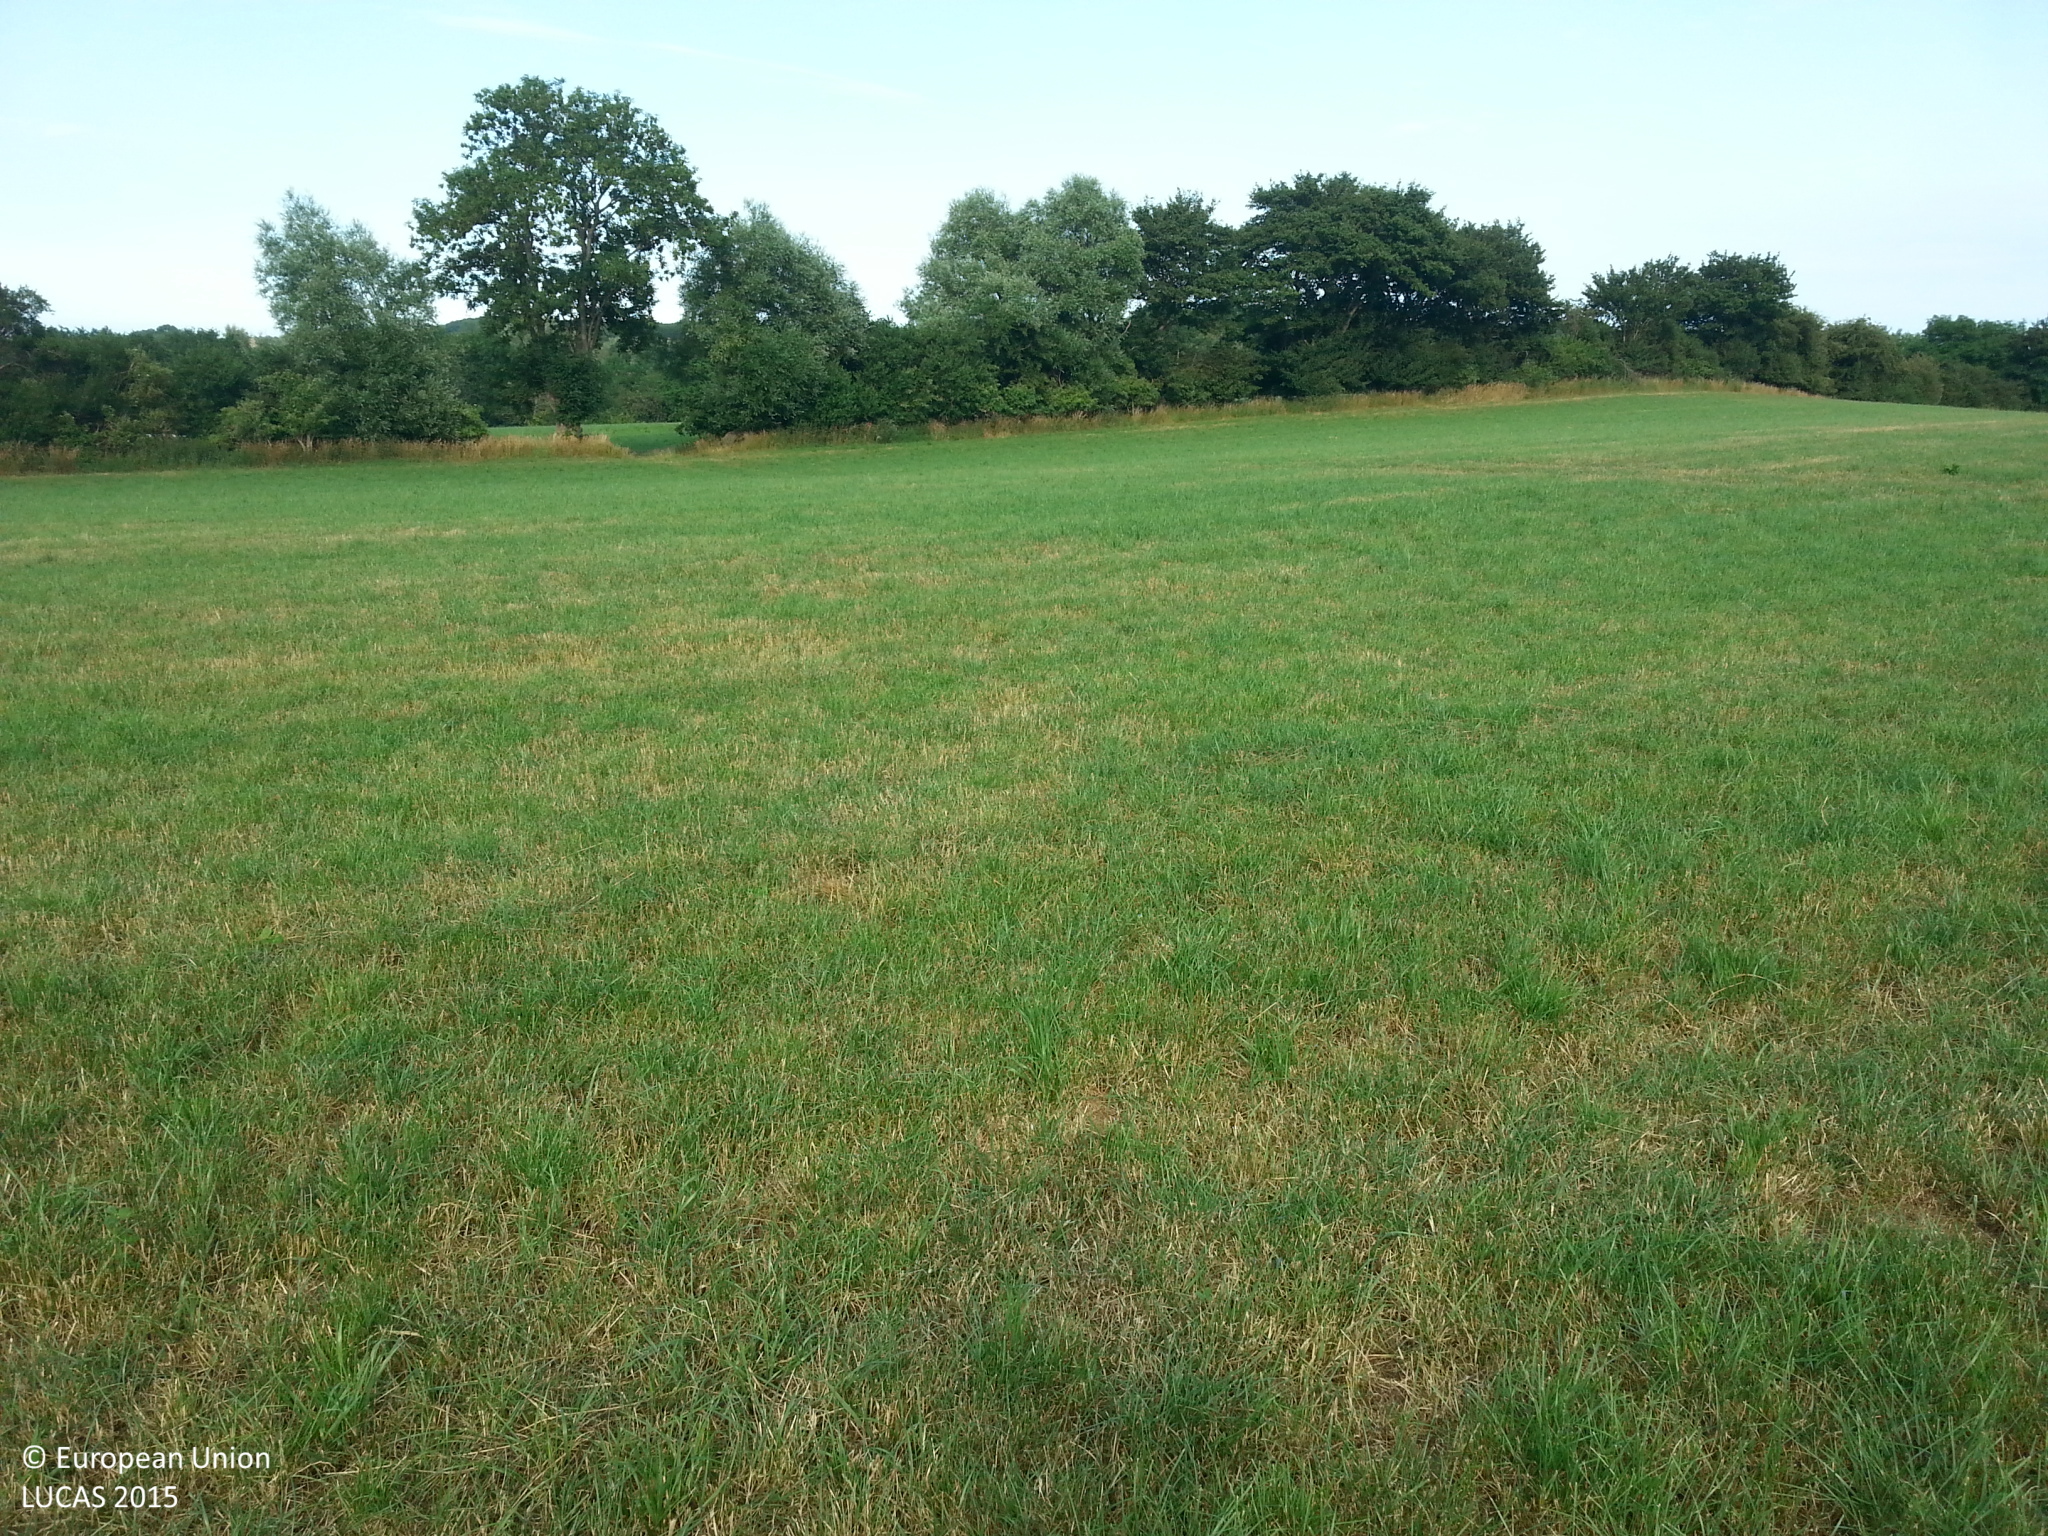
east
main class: Grassland
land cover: Grassland without tree/shrub cover
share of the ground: > 75 %
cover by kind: herbaceous plants 100 %
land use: Agriculture (excluding fallow land and kitchen gardens)
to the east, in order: Grassland without tree/shrub cover; Broadleaved woodland; Grassland without tree/shrub cover; Broadleaved woodland; Electric lines; Broadleaved woodland
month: July
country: DE
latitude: 54.0076
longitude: 11.1438
